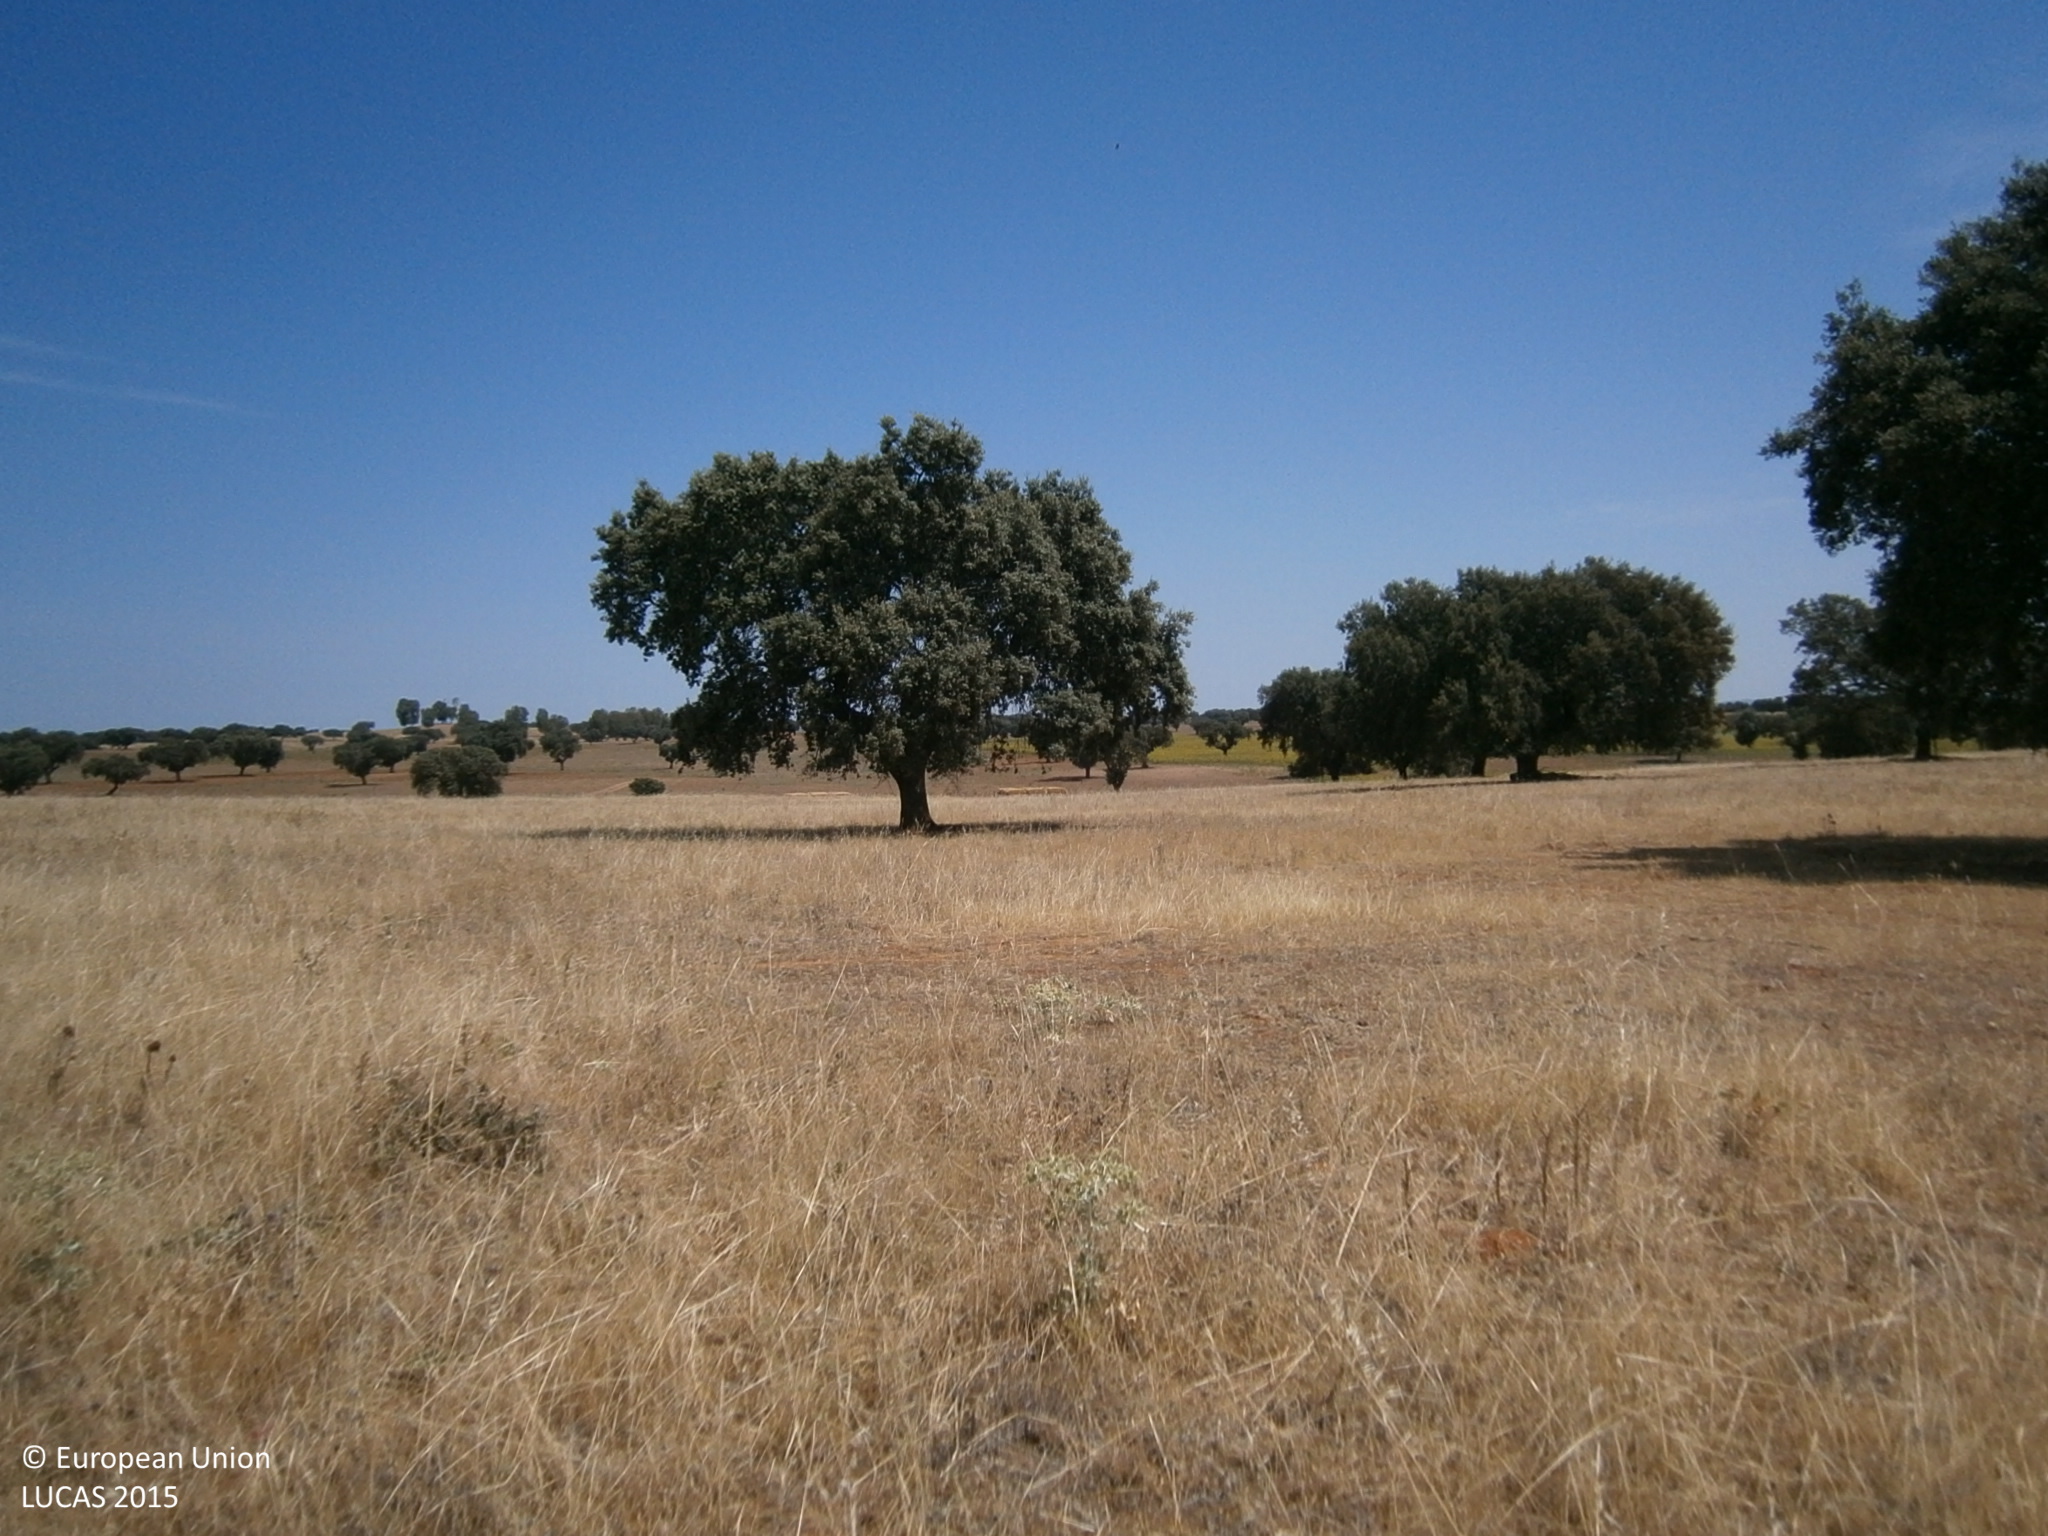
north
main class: Grassland
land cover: Grassland with sparse tree/shrub cover
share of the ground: > 75 %
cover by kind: herbaceous plants 90 %, broadleaved forest trees 5 %, unconsolidated bare surface 5 %
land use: Agriculture (excluding fallow land and kitchen gardens)
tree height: > 5 m
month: July
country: ES
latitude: 38.9878
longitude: -6.8200
